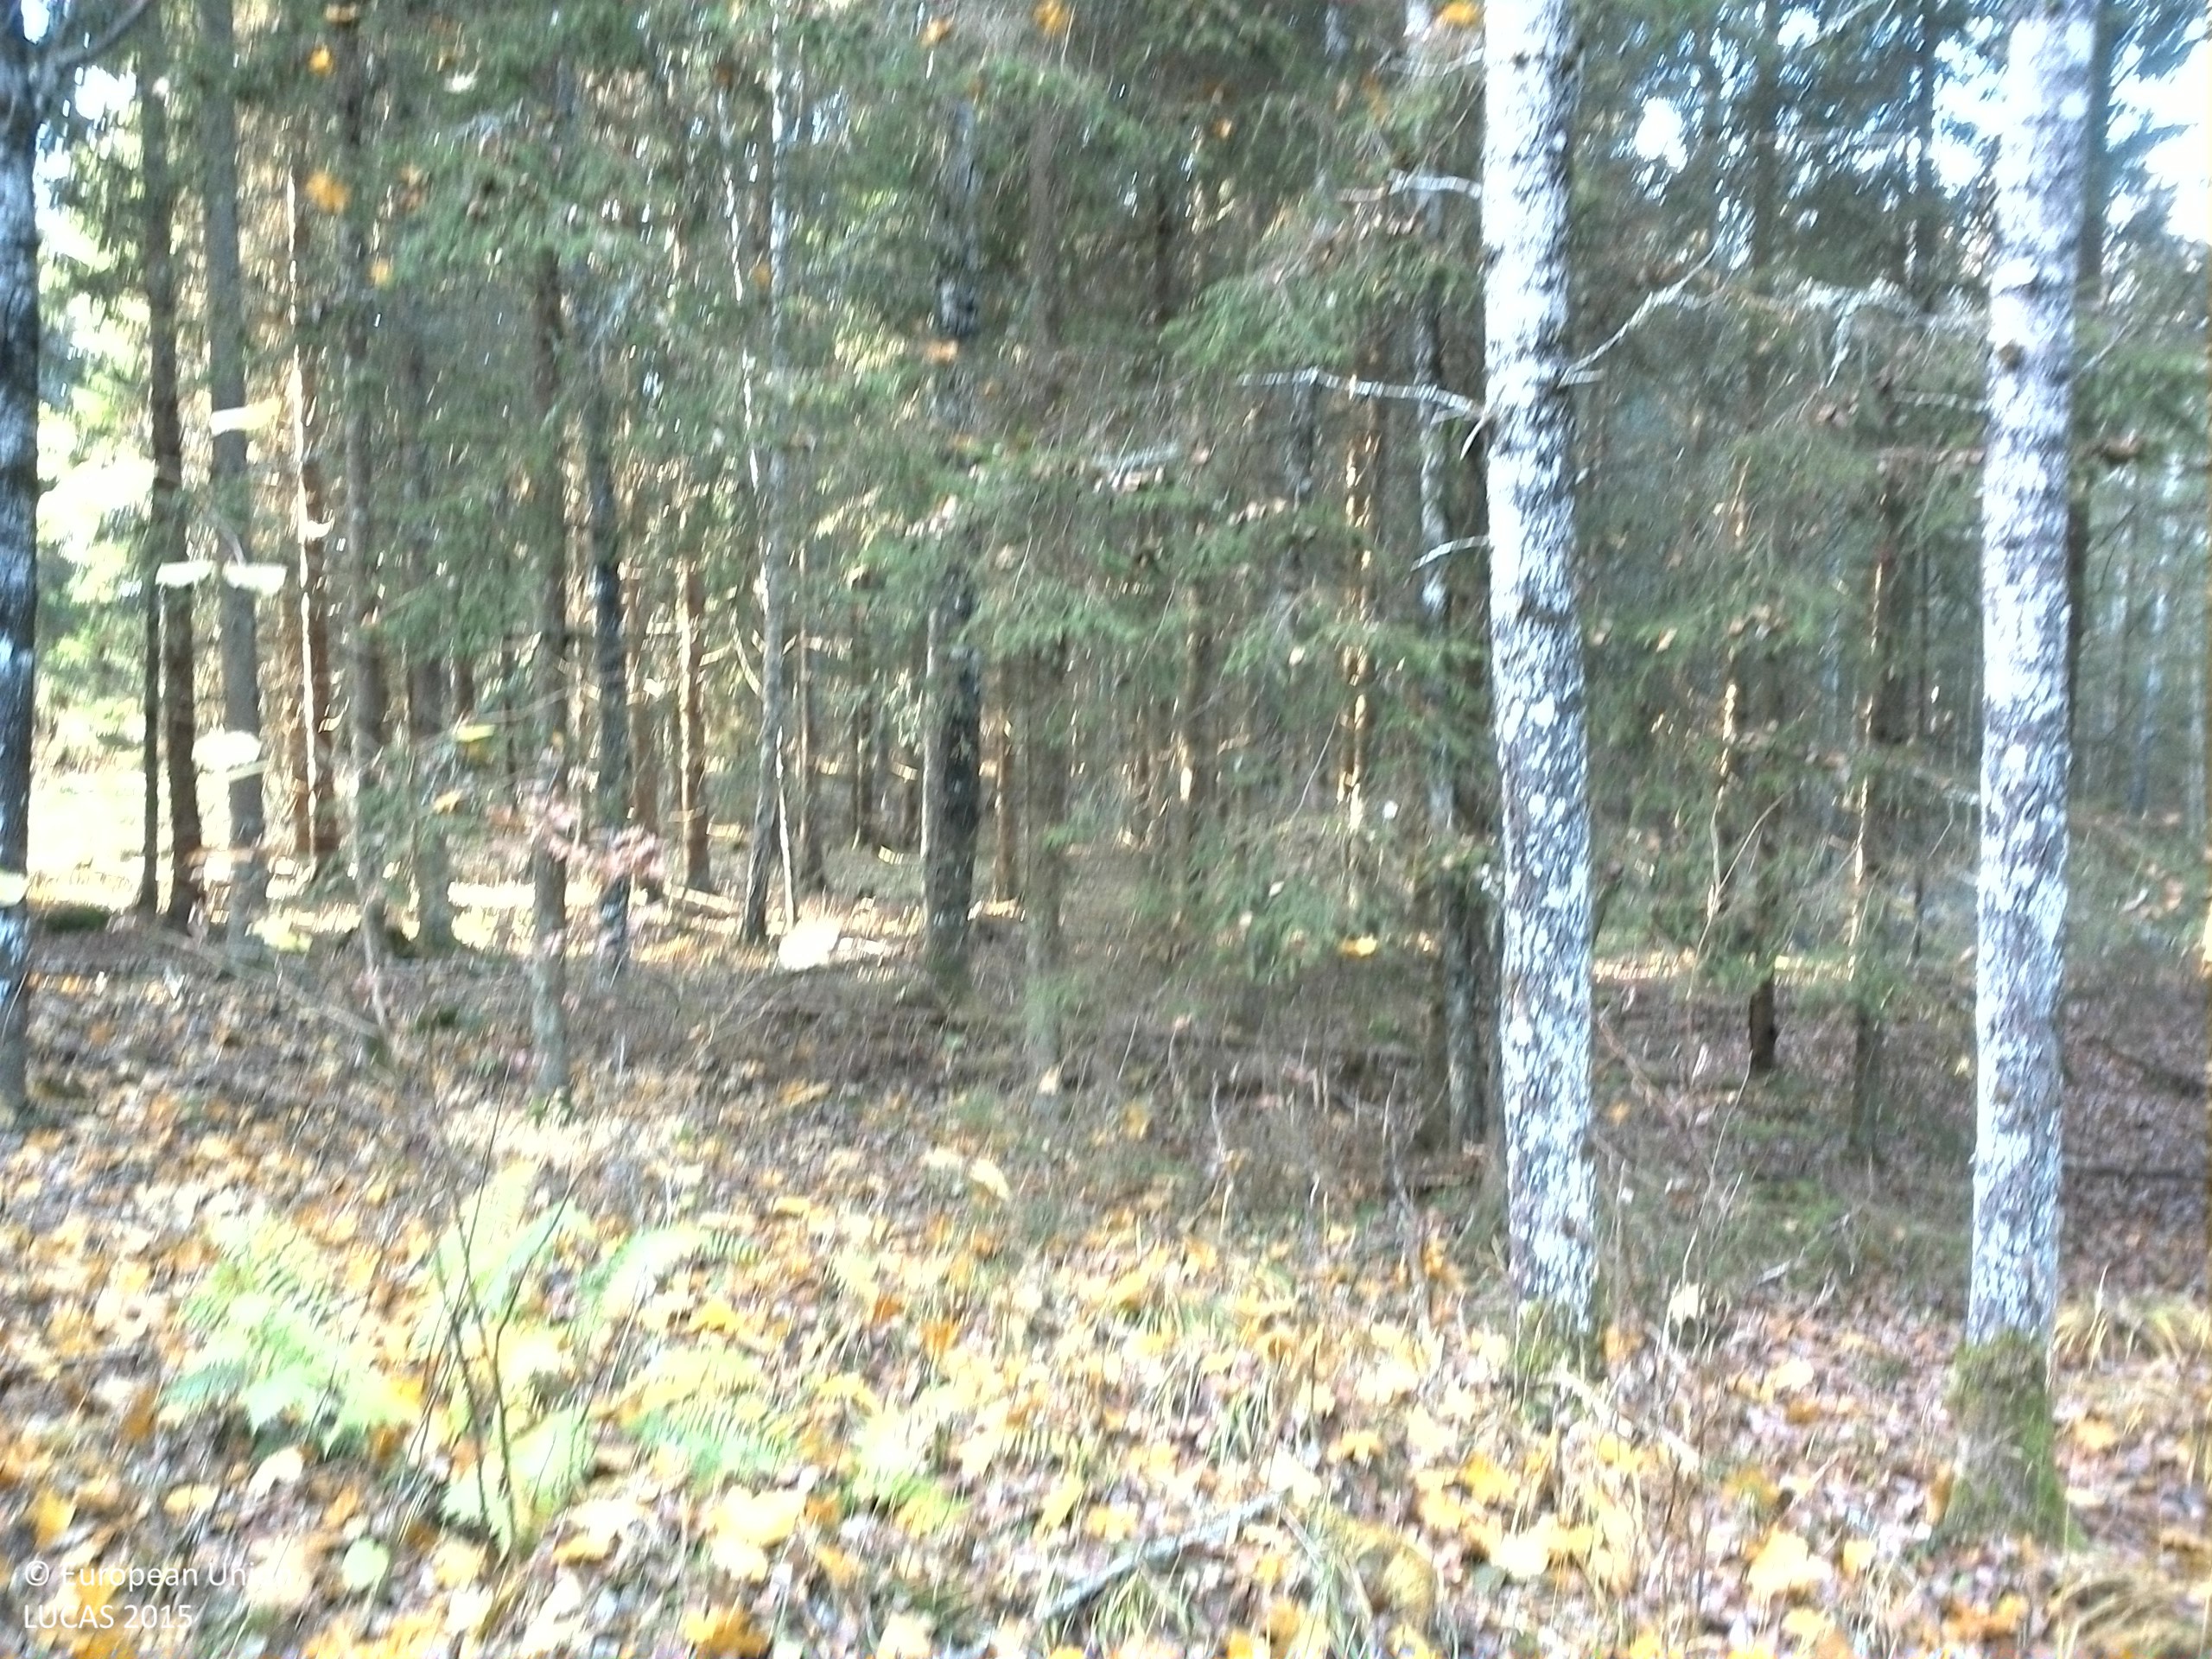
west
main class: Woodland
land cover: Spruce dominated mixed woodland
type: boreal forest
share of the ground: 50 - 75 %
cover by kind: coniferous forest trees 35 %, broadleaved forest trees 35 %, herbaceous plants 20 %, shrubs 10 %
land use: Forestry
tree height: > 5 m
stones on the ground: < 10 %
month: November
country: SE
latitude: 57.9233
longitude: 14.6377
